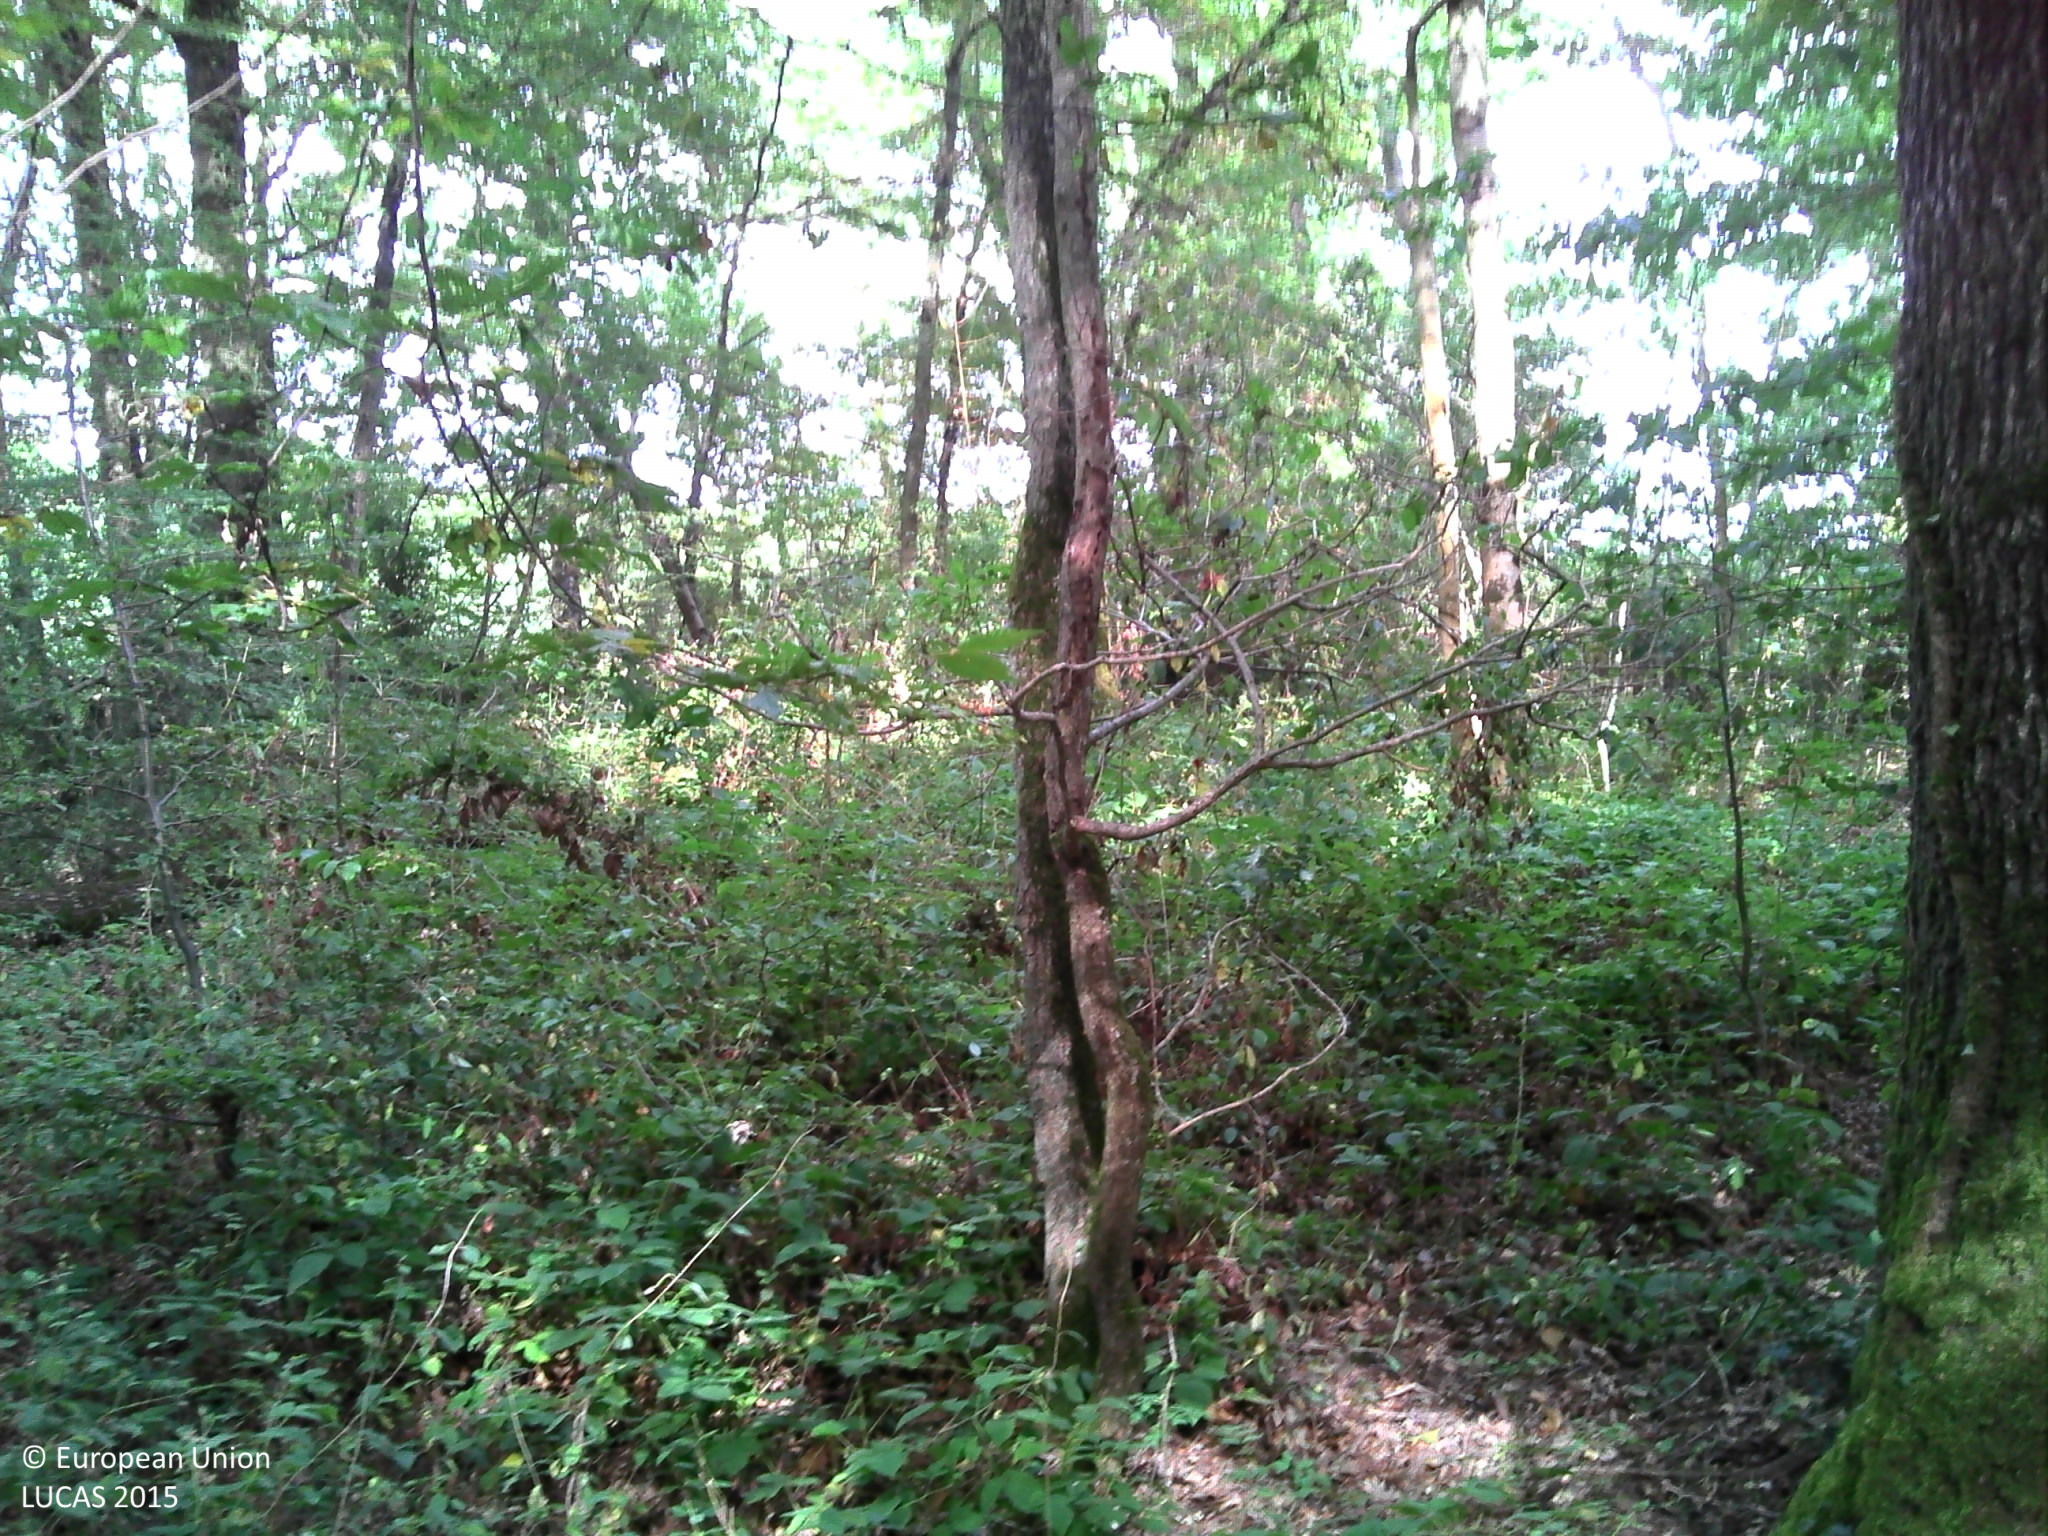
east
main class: Woodland
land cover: Broadleaved woodland
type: mesophytic deciduous forest
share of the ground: > 75 %
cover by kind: broadleaved forest trees 85 %, herbaceous plants 5 %, lichens and mosses 5 %
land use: Forestry
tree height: > 5 m
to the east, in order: Broadleaved woodland; Fences; Tracks; Common wheat; Grassland without tree/shrub cover; Common wheat
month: July
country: FR
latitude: 48.1482
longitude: 3.0438
